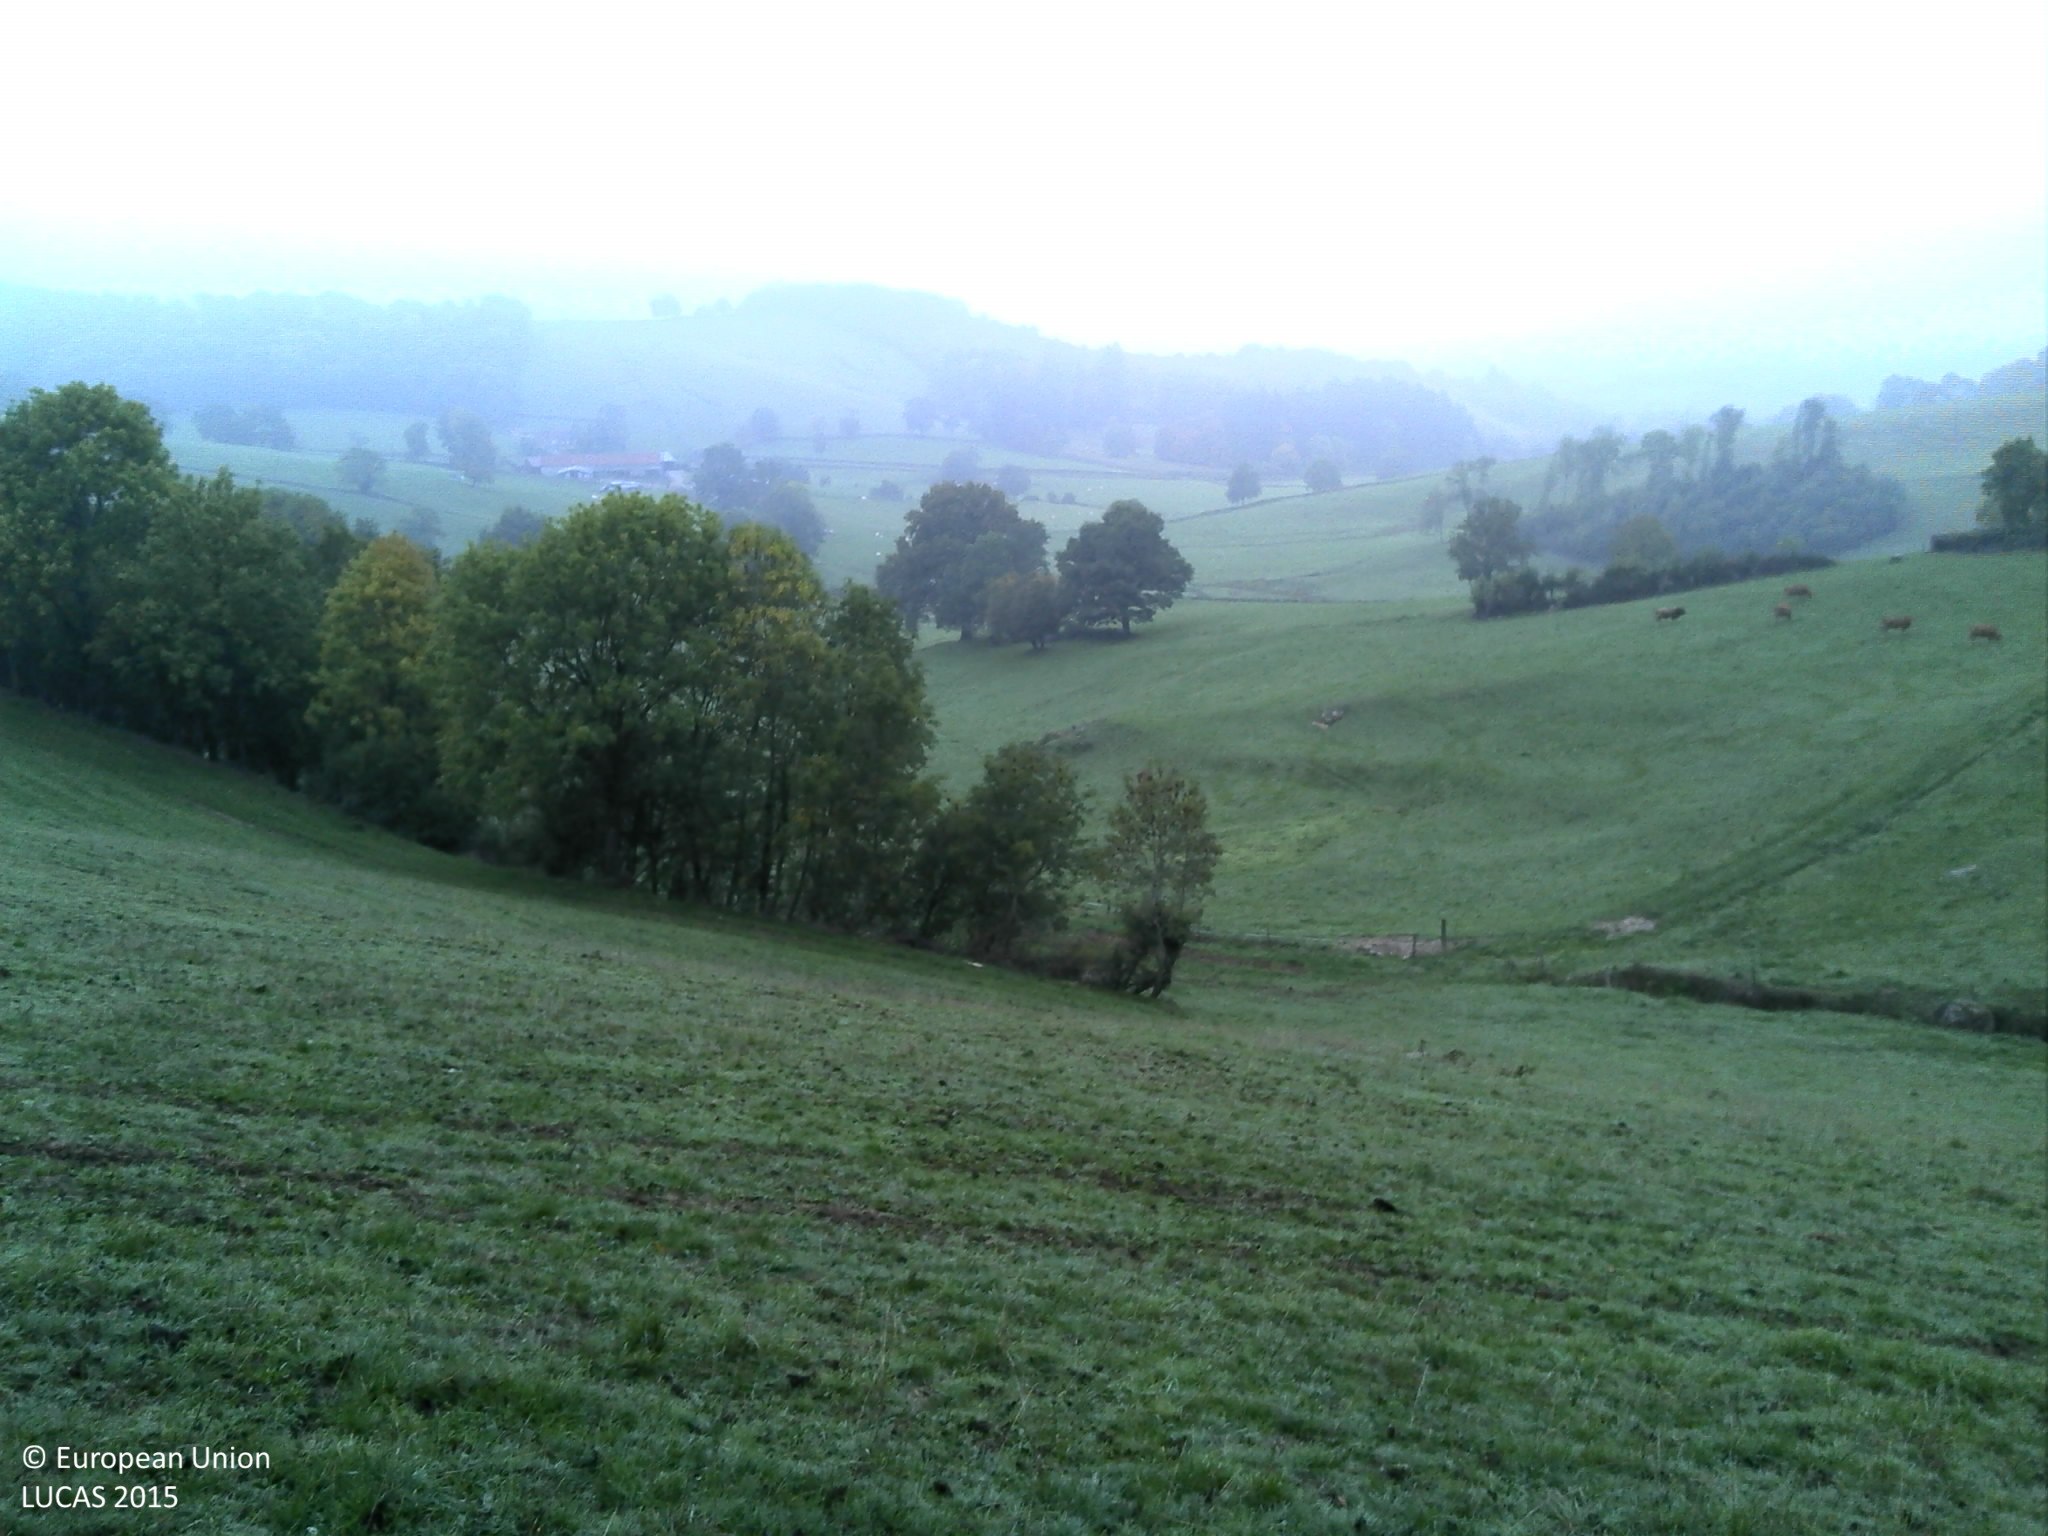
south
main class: Grassland
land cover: Grassland without tree/shrub cover
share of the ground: > 75 %
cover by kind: herbaceous plants 100 %
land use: Agriculture (excluding fallow land and kitchen gardens)
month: October
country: FR
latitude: 46.7809
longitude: 4.0401
